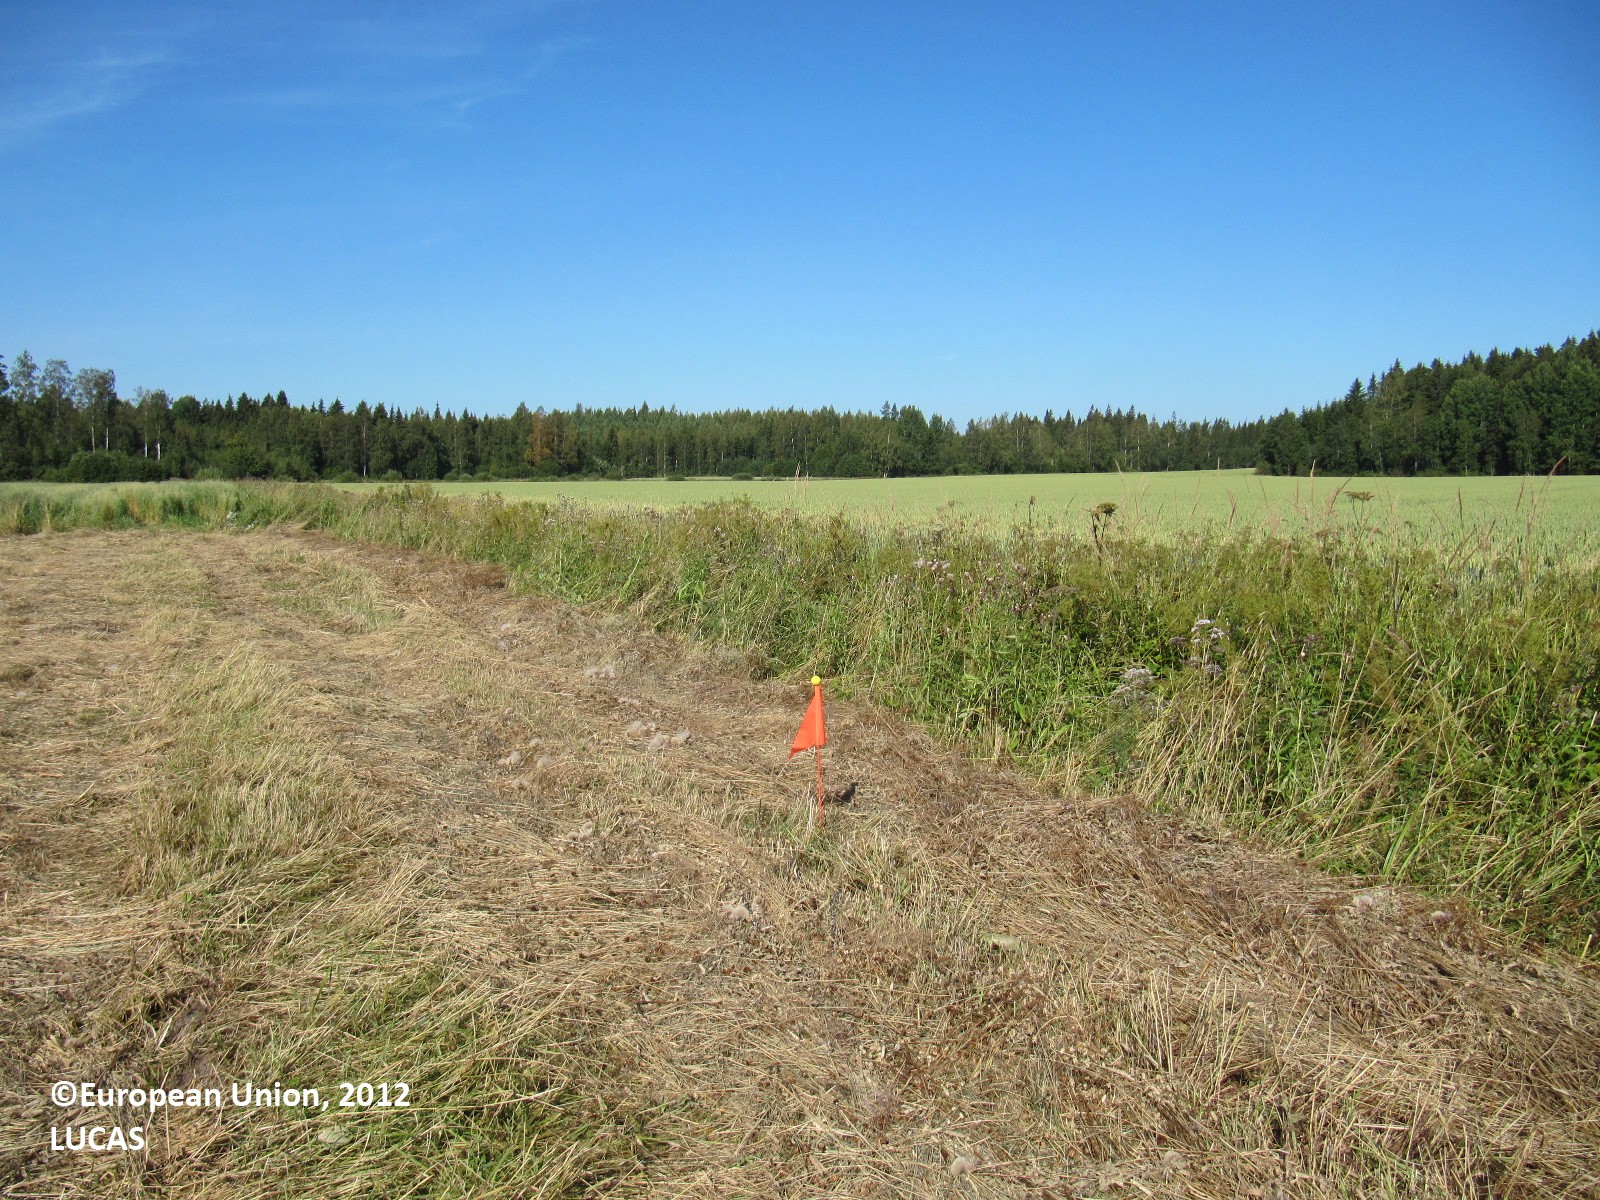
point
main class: Grassland
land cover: Grassland without tree/shrub cover
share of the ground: > 75 %
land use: Agriculture (excluding fallow land and kitchen gardens)
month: August
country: FI
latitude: 60.7080
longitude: 24.5255
